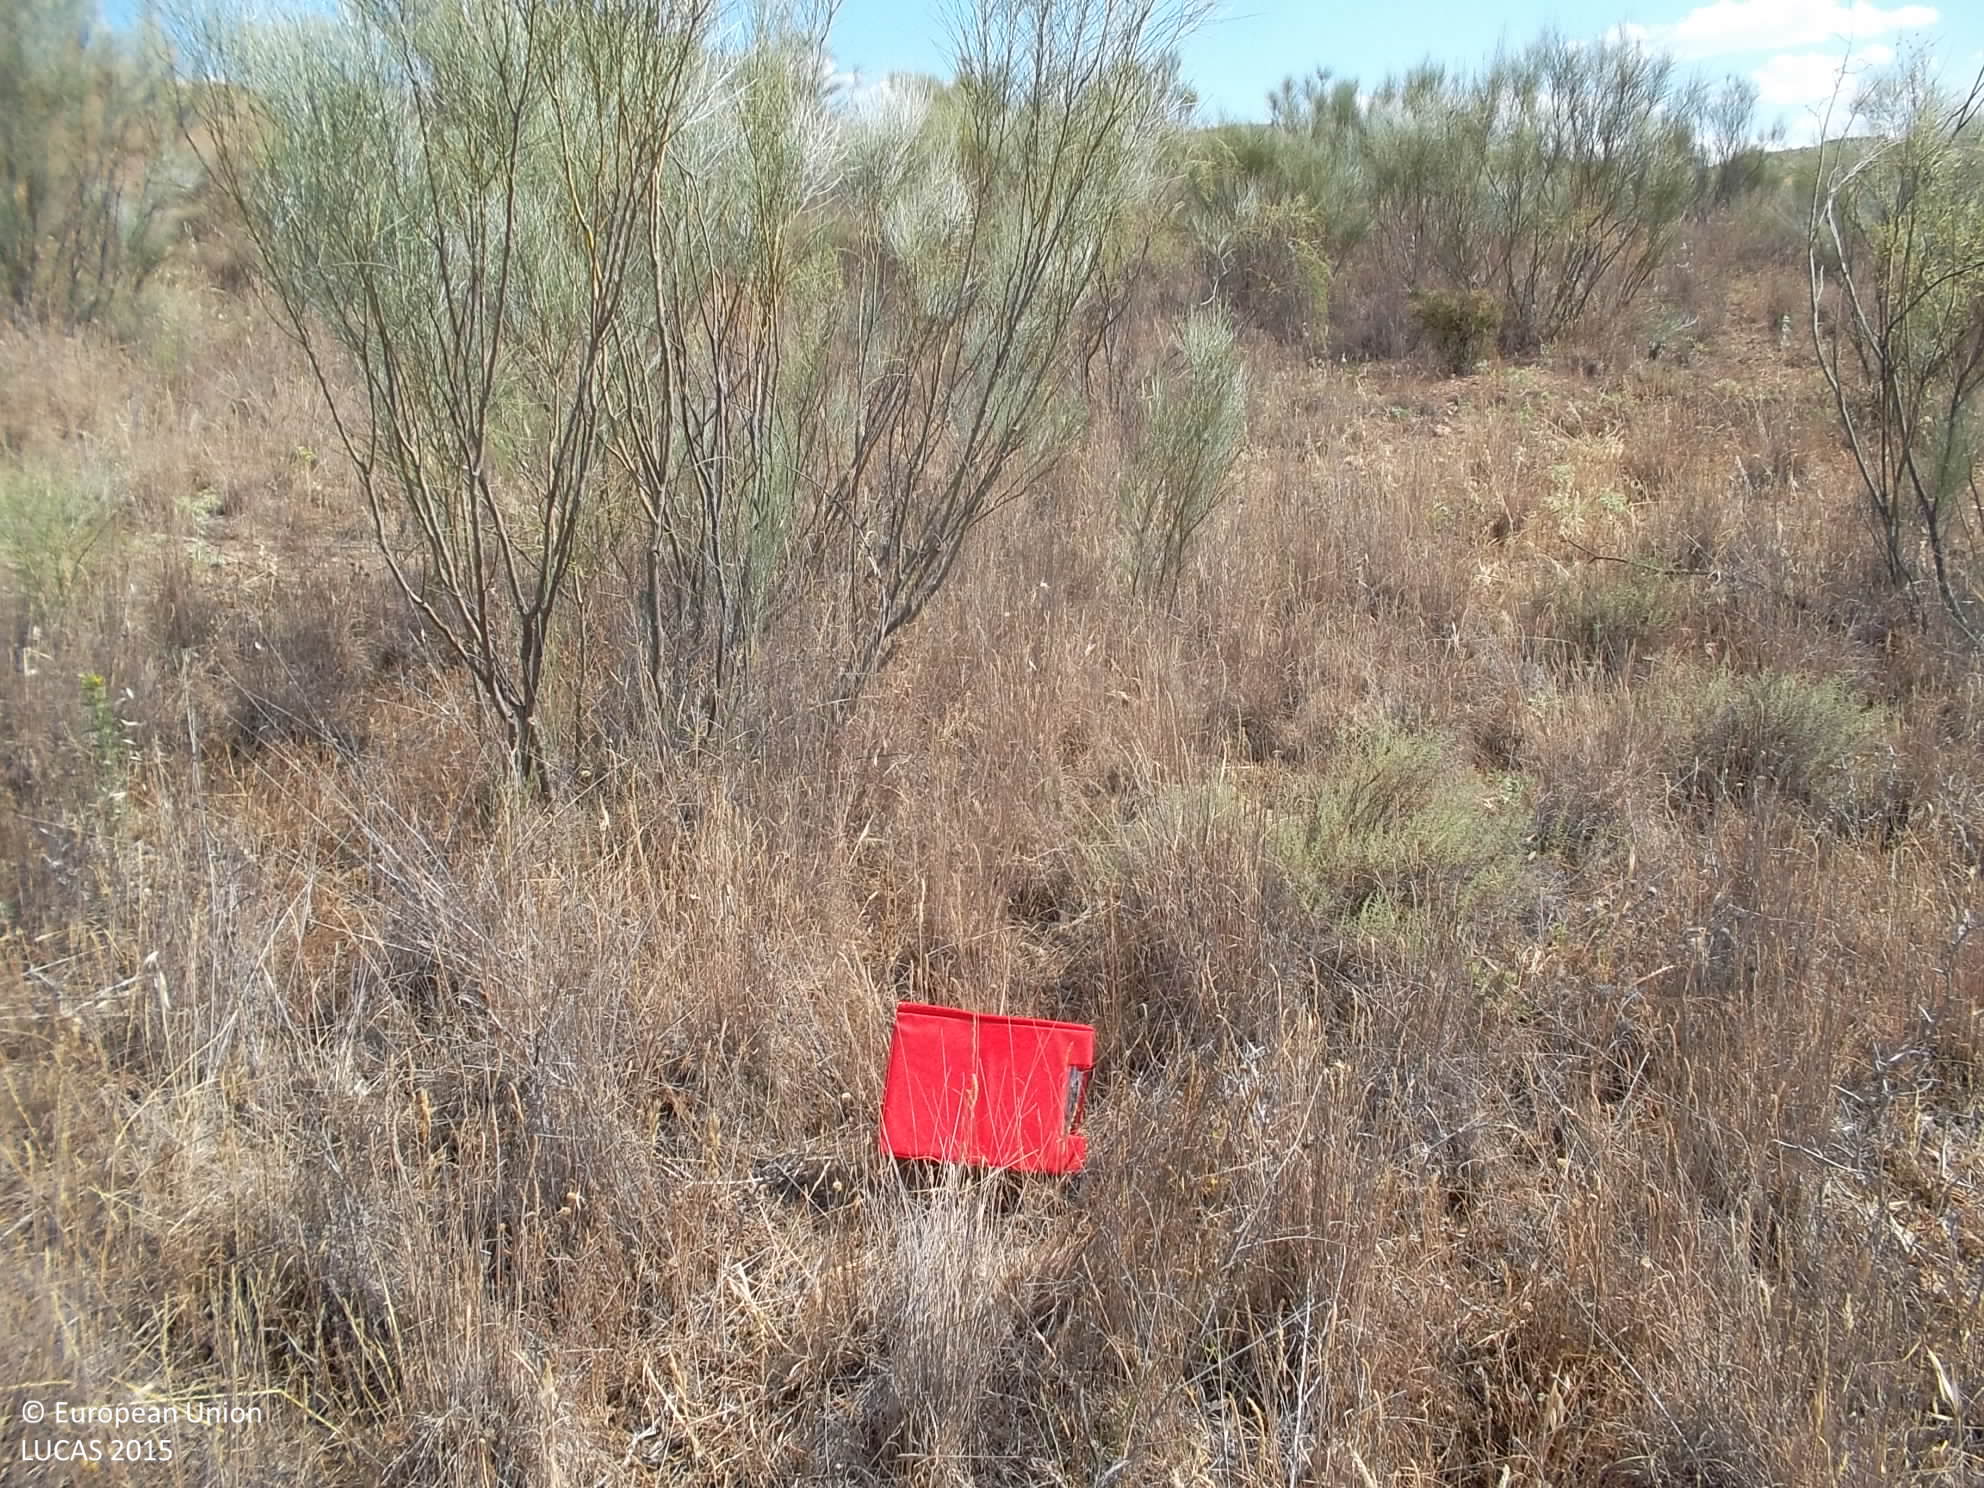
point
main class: Grassland
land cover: Grassland with sparse tree/shrub cover
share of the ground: > 75 %
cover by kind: herbaceous plants 85 %, shrubs 10 %, broadleaved forest trees 5 %
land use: Agriculture (excluding fallow land and kitchen gardens)
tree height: < 5 m
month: June
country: ES
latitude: 37.6847
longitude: -3.2041
